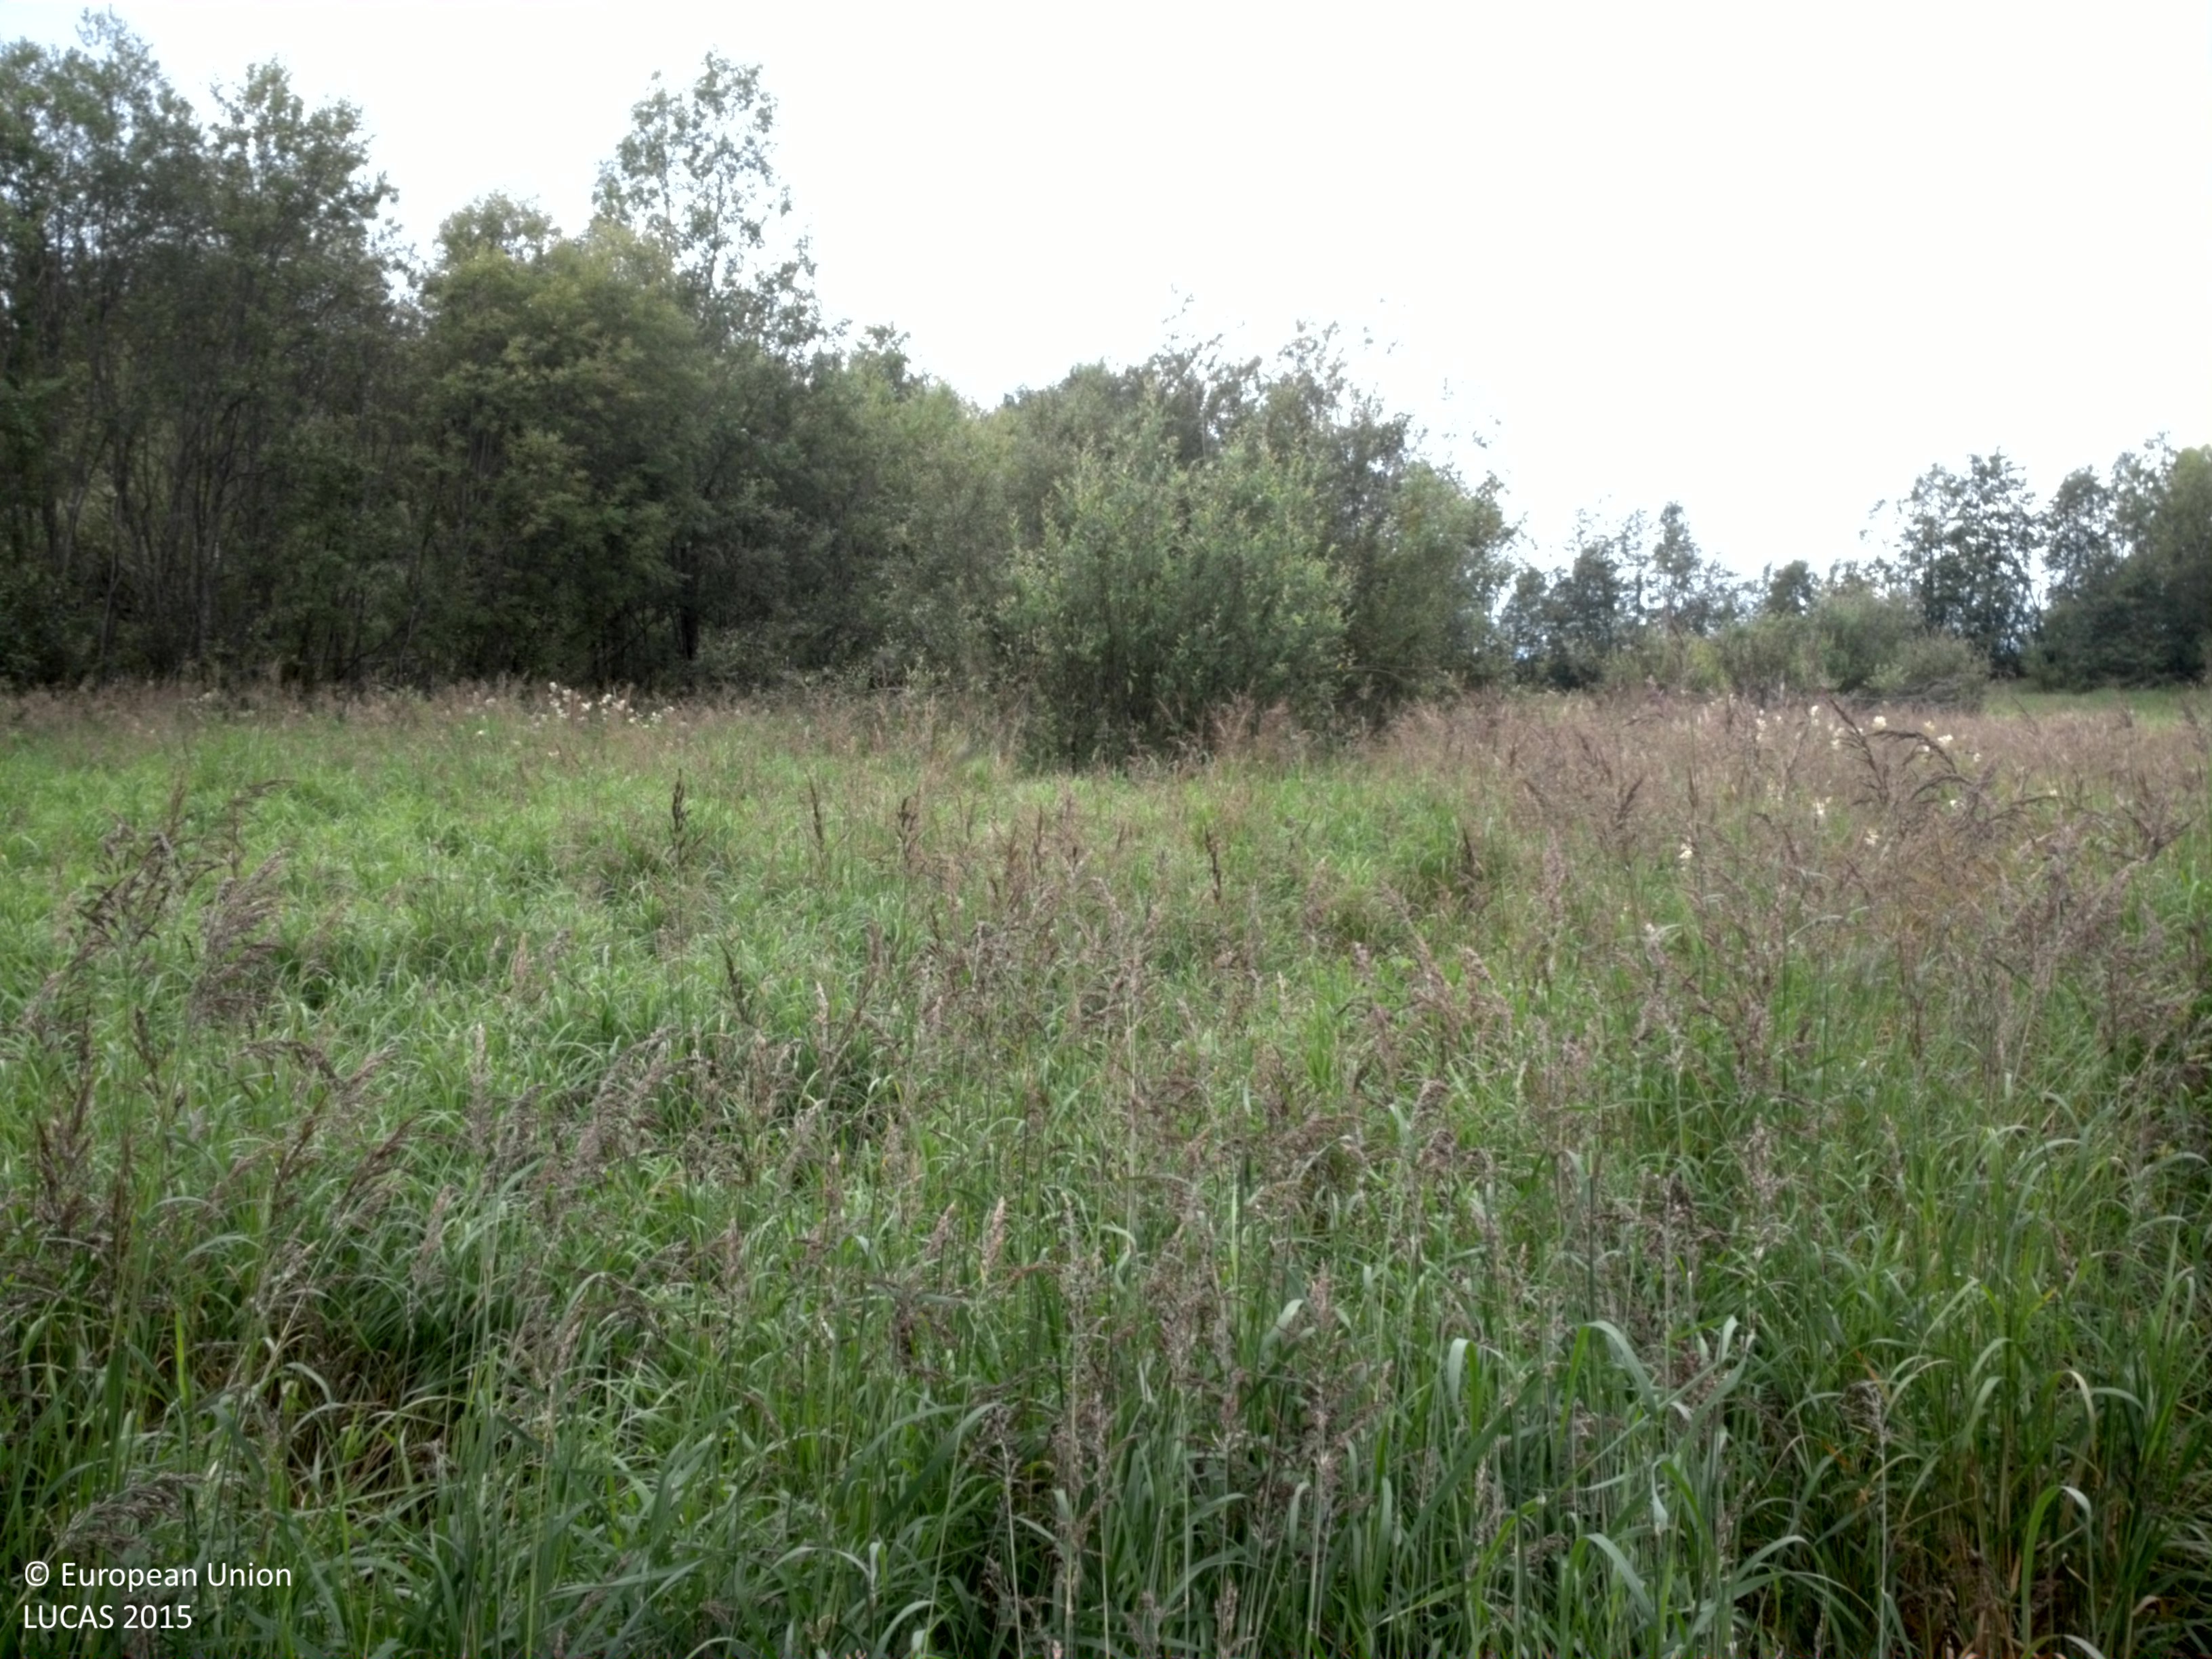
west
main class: Grassland
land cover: Grassland with sparse tree/shrub cover
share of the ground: > 75 %
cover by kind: herbaceous plants 95 %, broadleaved forest trees 5 %
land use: Agriculture (excluding fallow land and kitchen gardens)
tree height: > 5 m
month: August
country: SE
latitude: 64.6413
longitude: 20.9235
